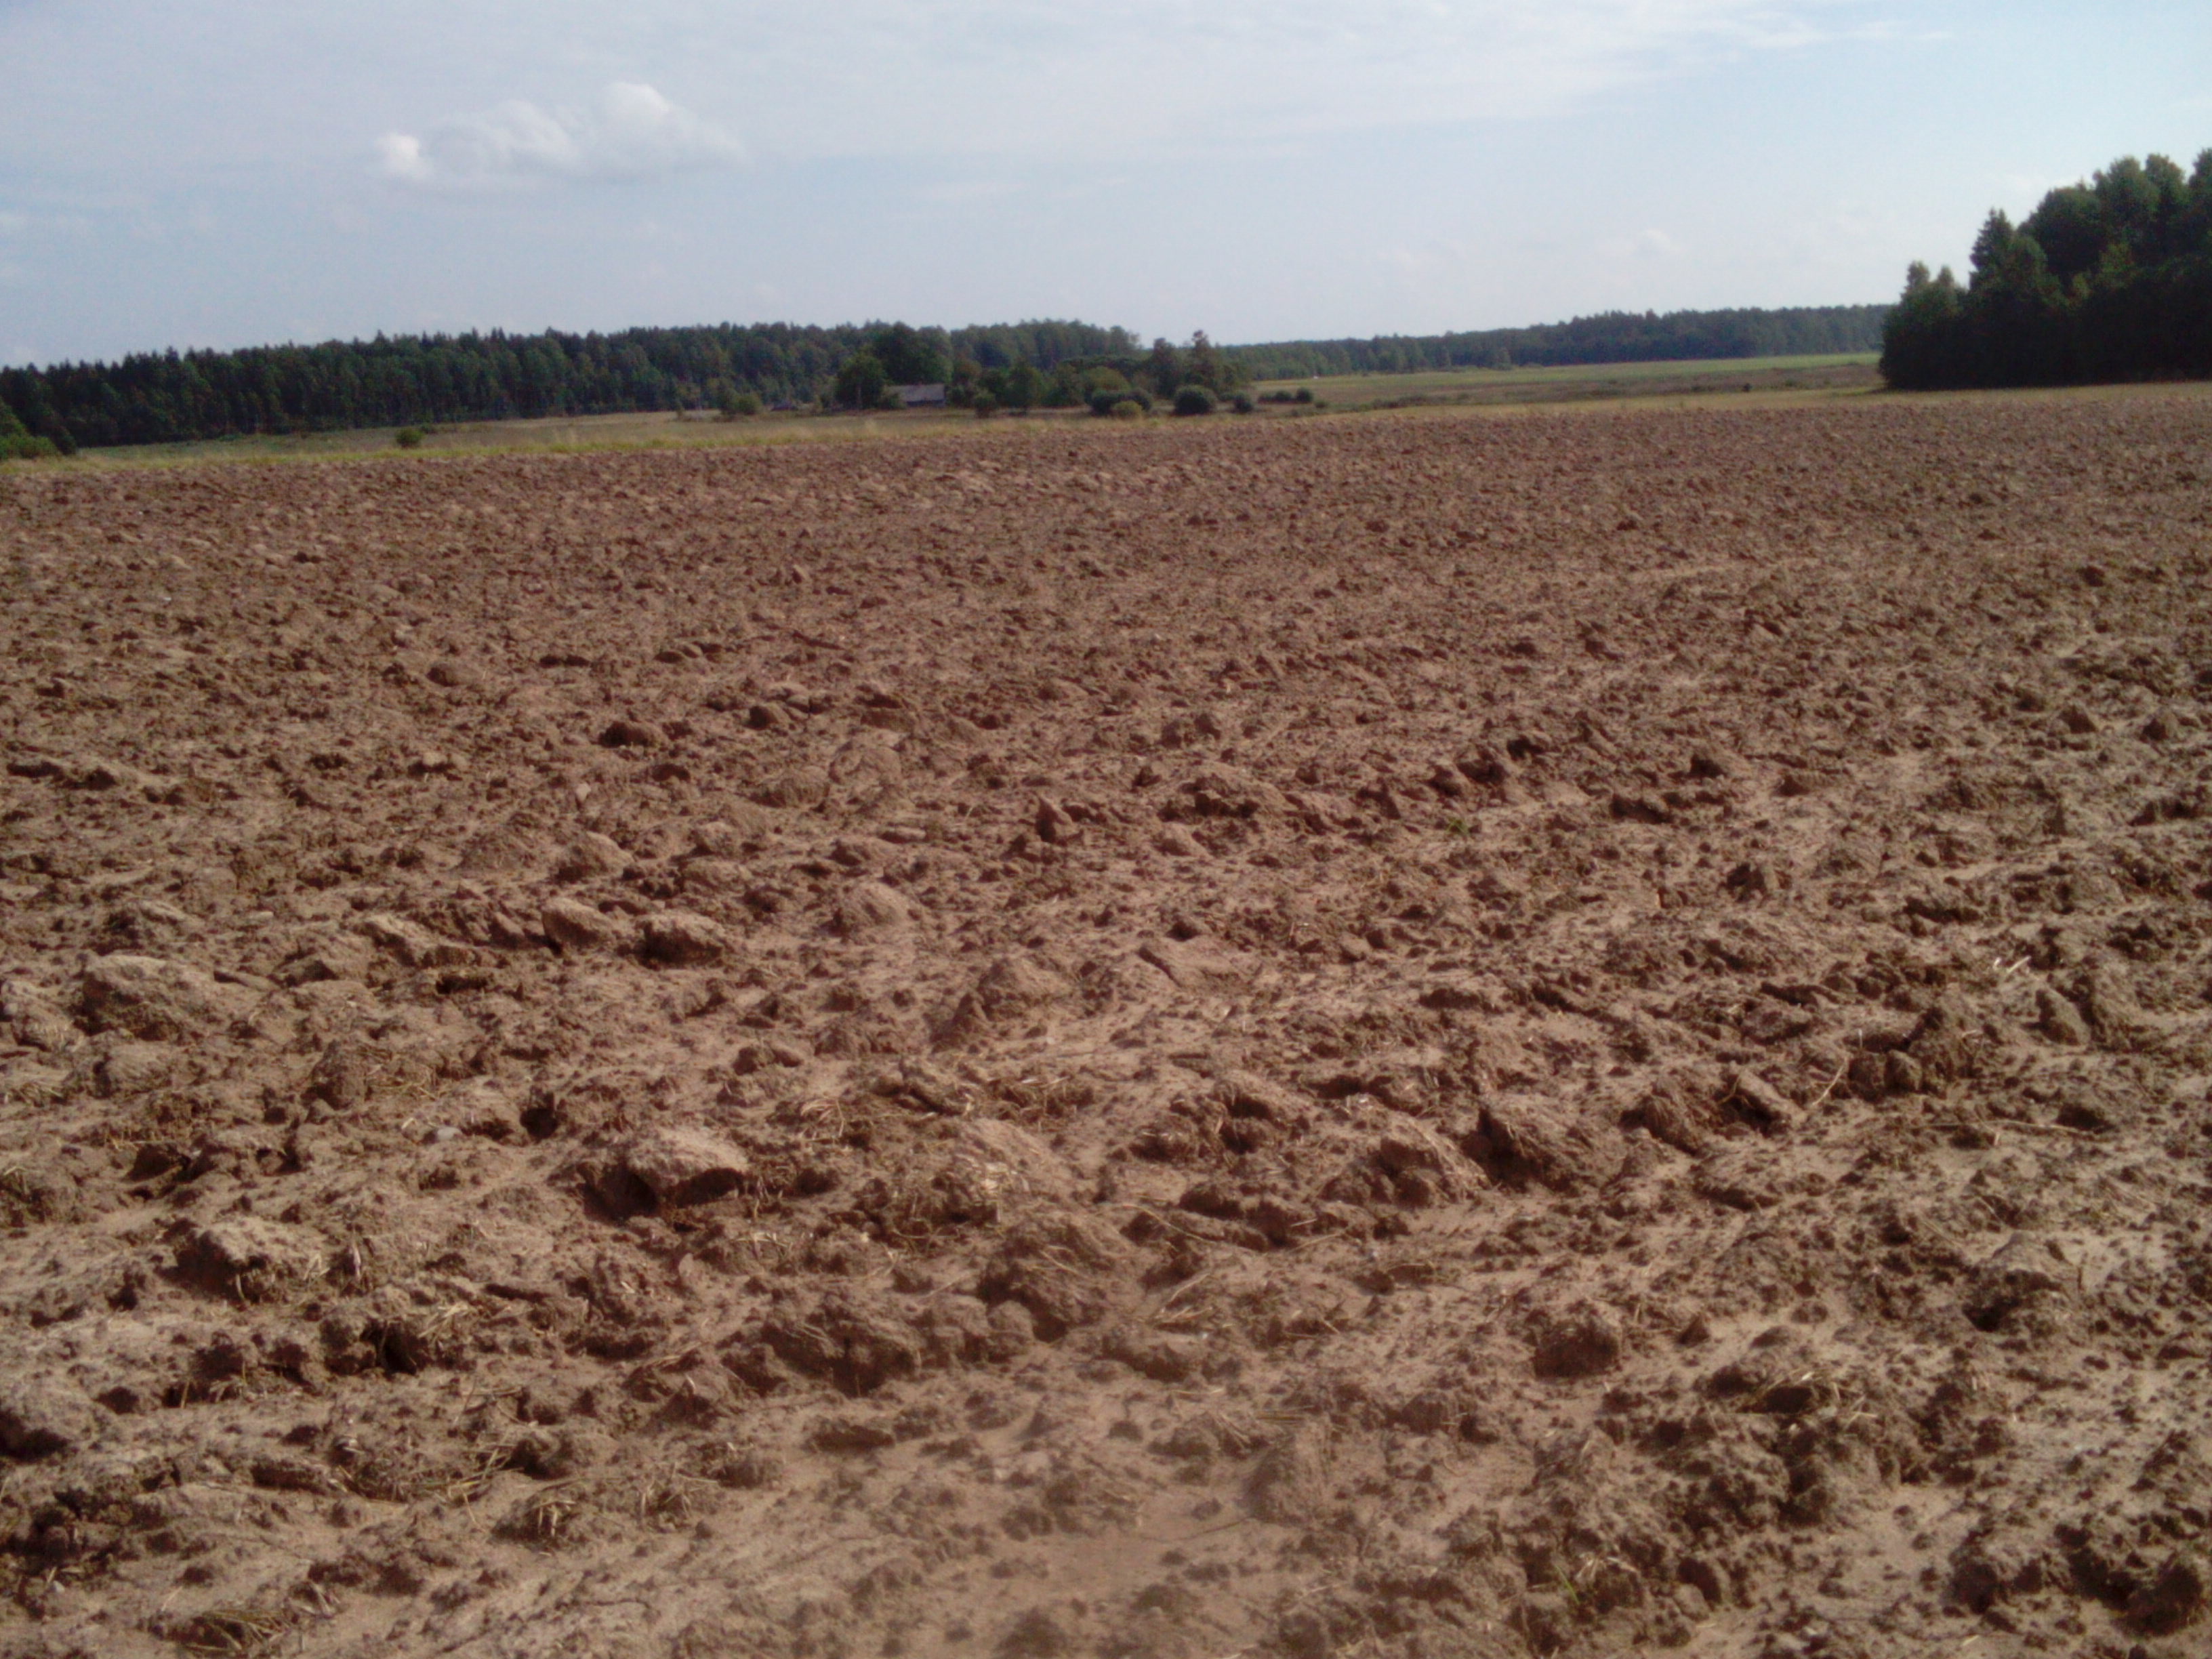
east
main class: Cropland
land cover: Dry pulses
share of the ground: < 10 %
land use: Agriculture (excluding fallow land and kitchen gardens)
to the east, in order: Dry pulses; Grass margins; Common wheat
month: September
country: LT
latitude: 55.7862
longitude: 22.7417
